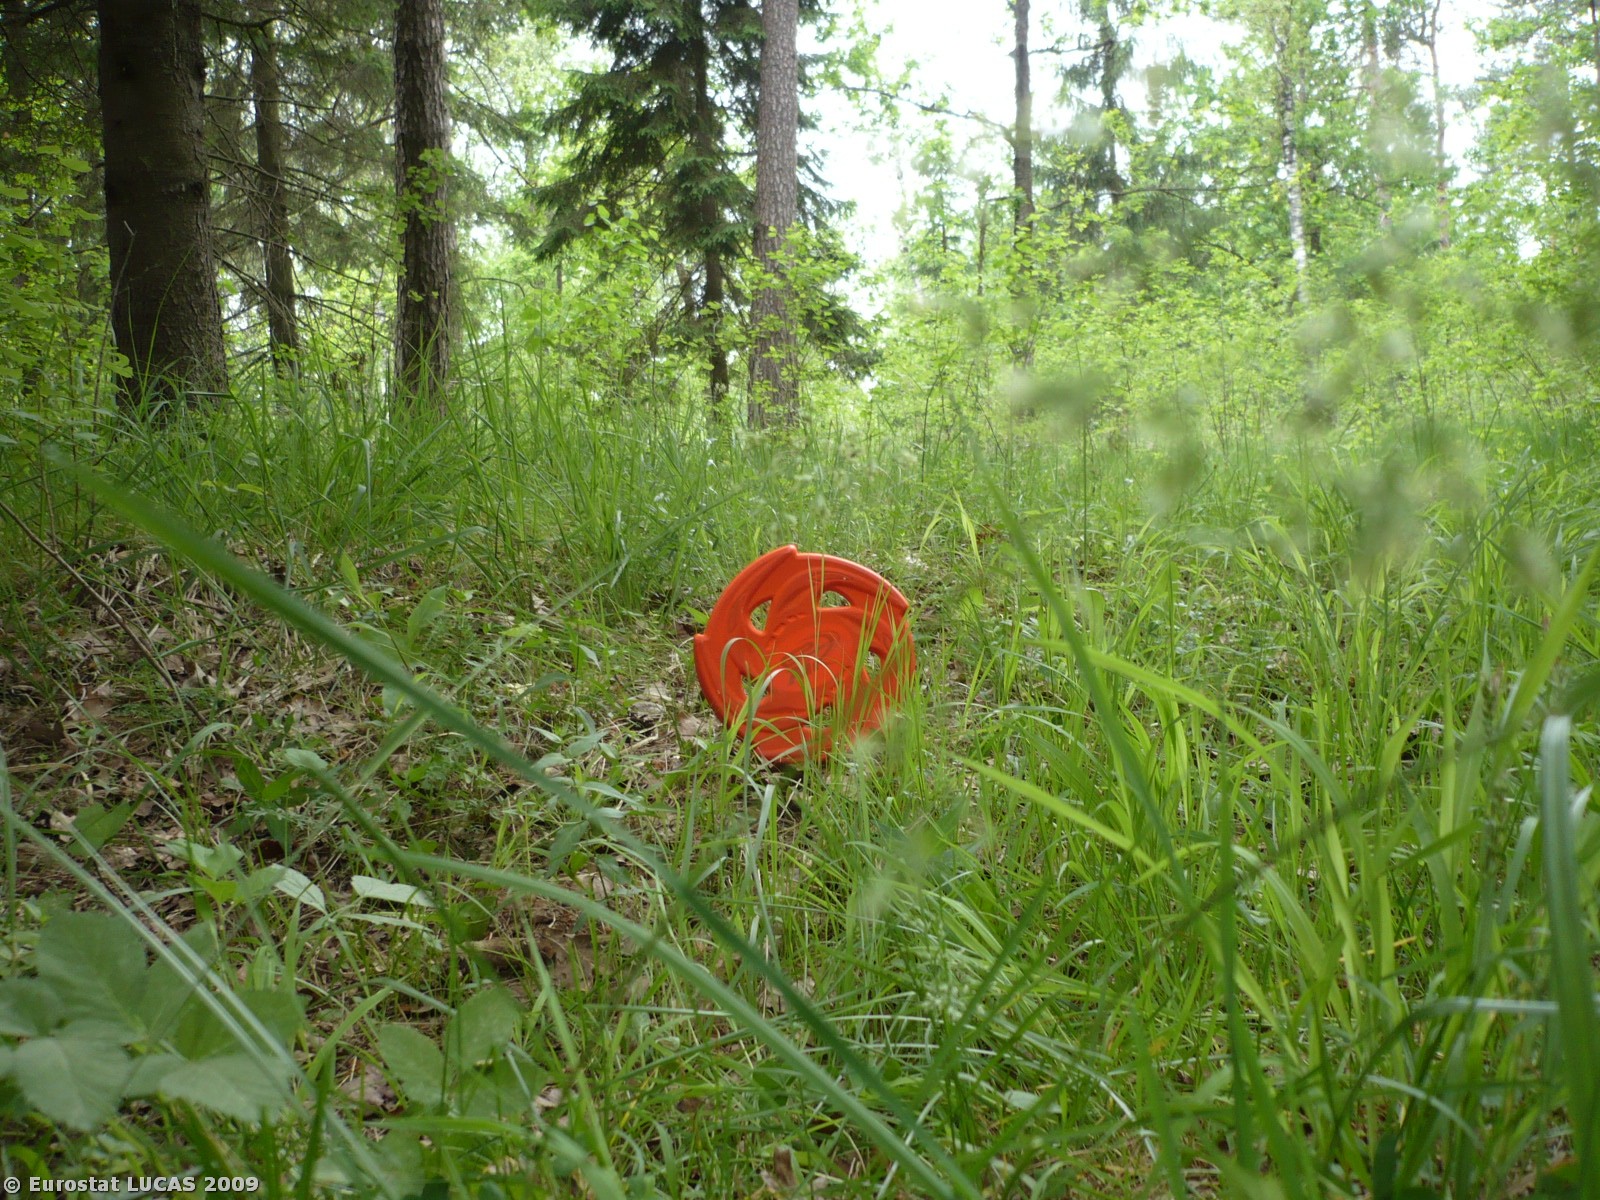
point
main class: Woodland
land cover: Mixed woodland
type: hemiboreal forest and nemoral coniferous forest and mixed broadleaved-coniferous forest
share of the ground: > 75 %
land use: Forestry
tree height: > 5 m
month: May
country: SI
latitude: 46.1721
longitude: 14.3617
